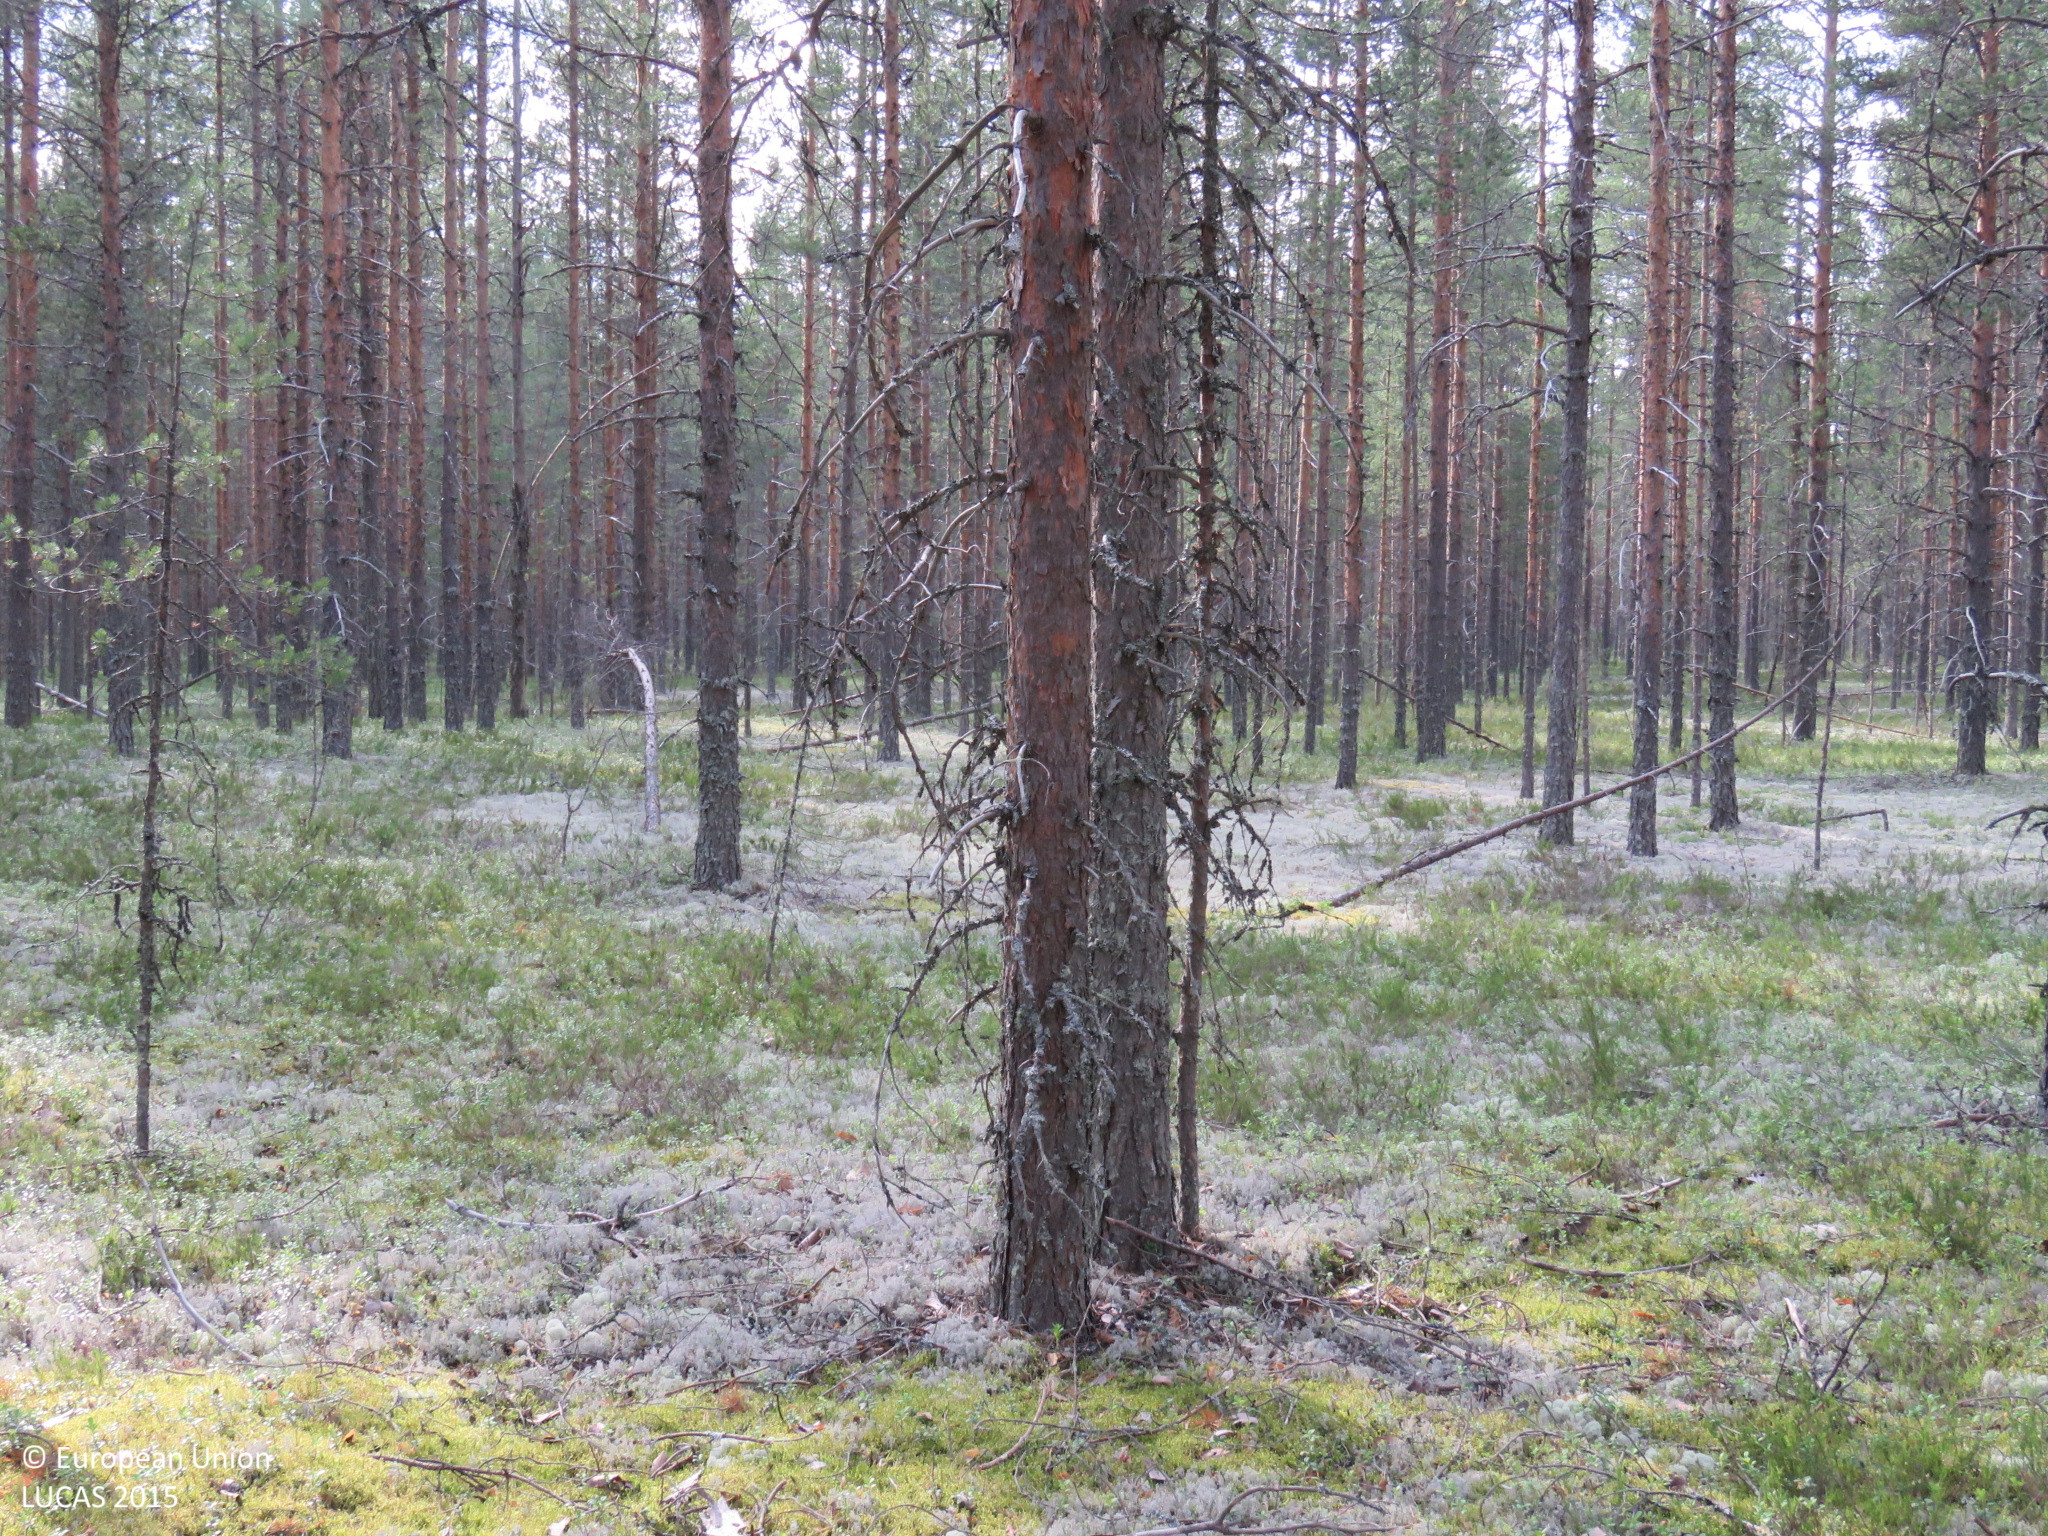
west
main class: Woodland
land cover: Pine dominated coniferous woodland
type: boreal forest
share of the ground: > 75 %
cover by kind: coniferous forest trees 80 %, shrubs 10 %, lichens and mosses 10 %
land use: Amenities, museums, leisure
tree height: > 5 m
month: July
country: FI
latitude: 64.5860
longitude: 26.4648
